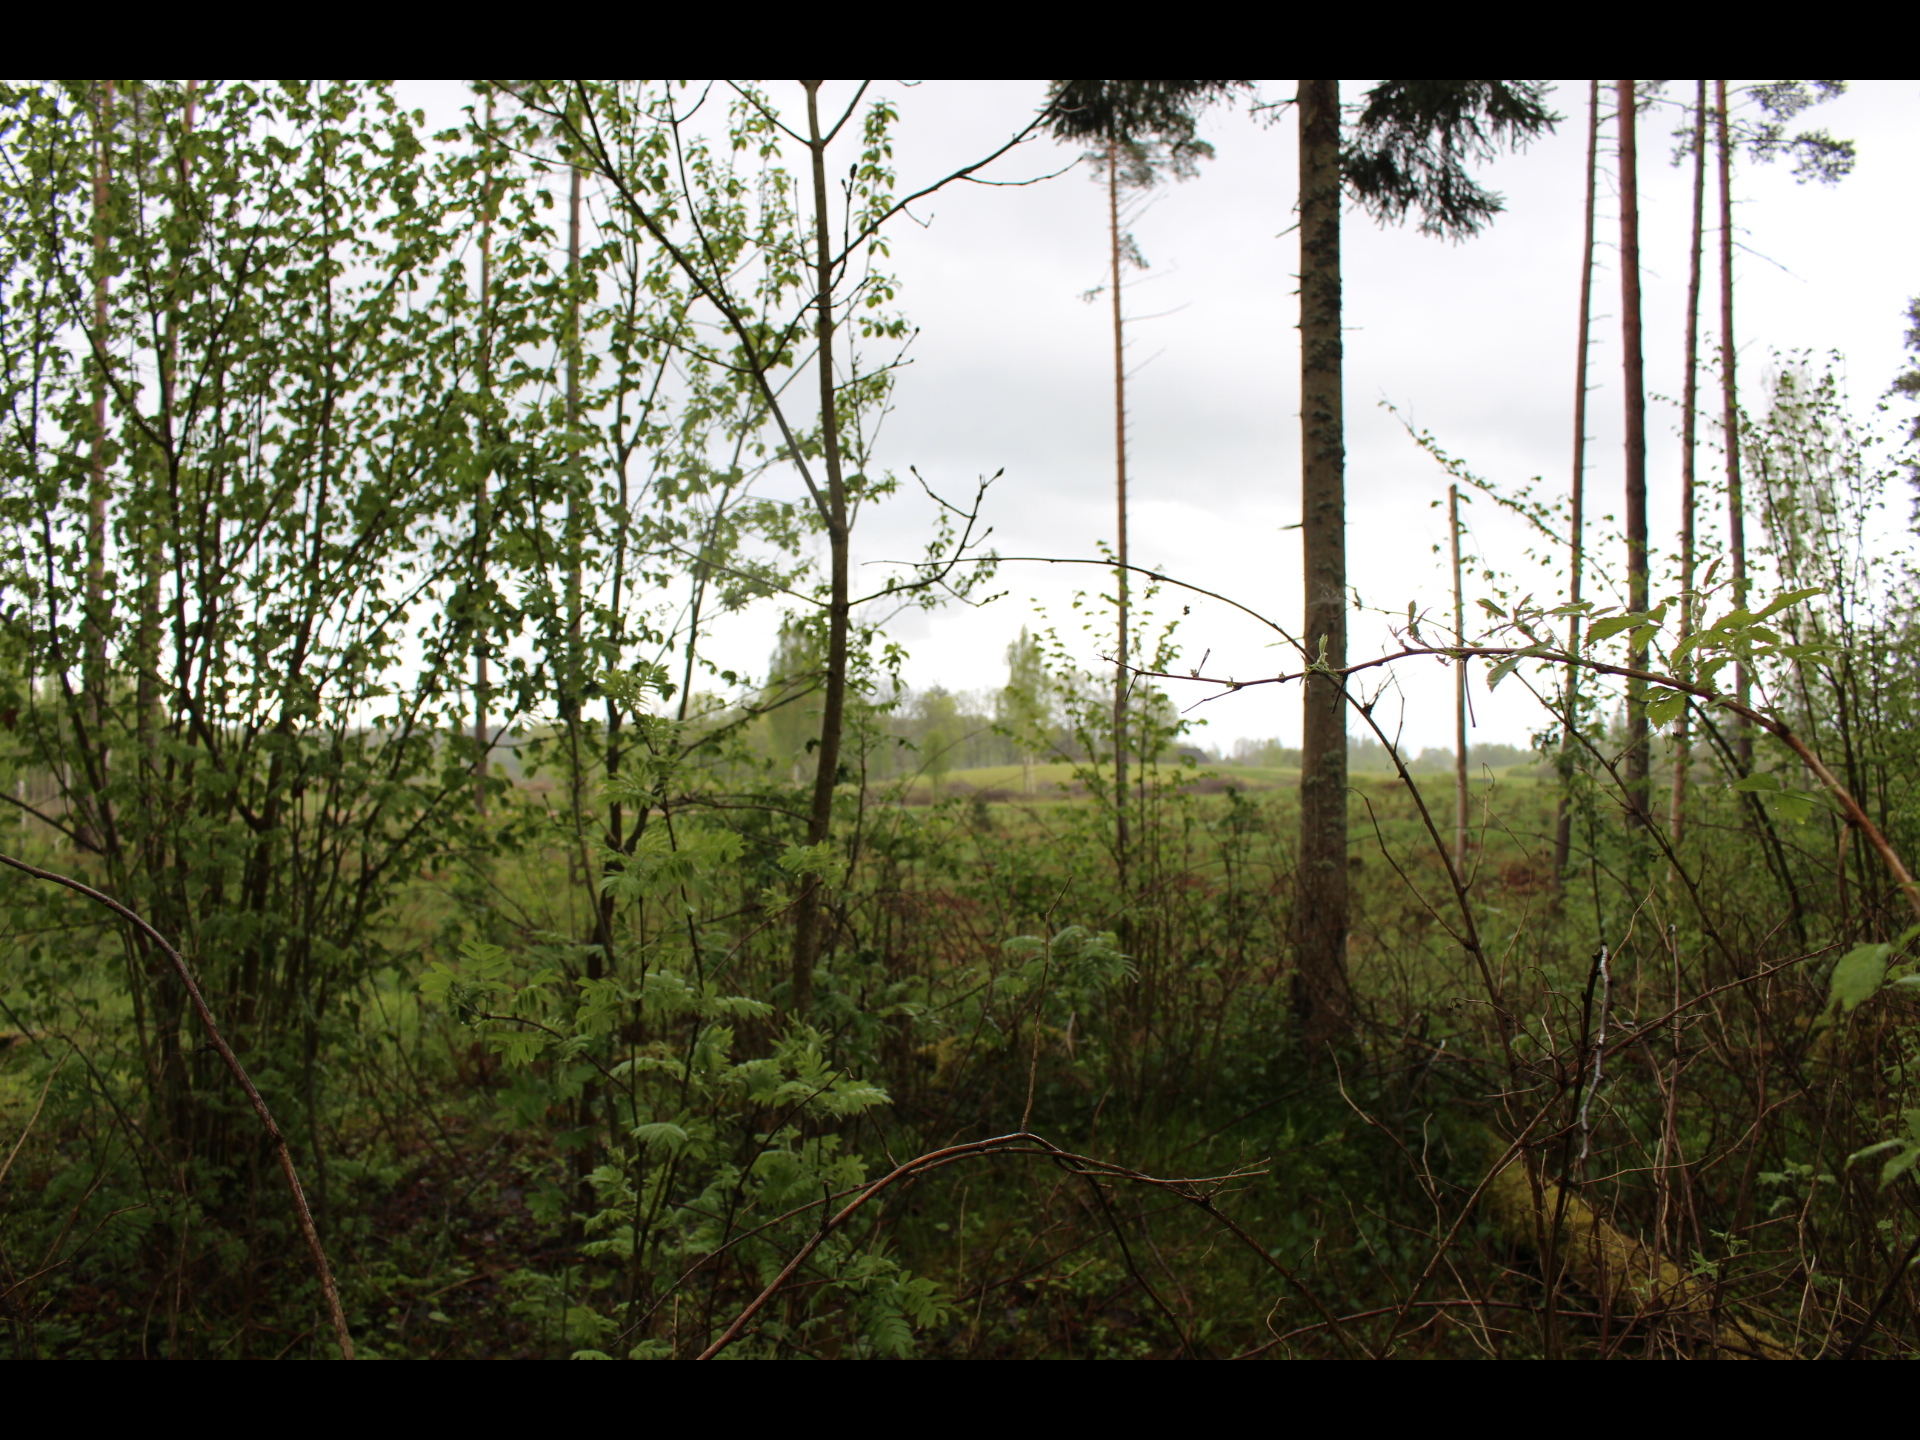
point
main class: Woodland
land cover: Pine dominated mixed woodland
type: hemiboreal forest and nemoral coniferous forest and mixed broadleaved-coniferous forest
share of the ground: > 75 %
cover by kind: broadleaved forest trees 60 %, coniferous forest trees 30 %, shrubs 10 %
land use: Forestry
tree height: > 5 m
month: May
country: LV
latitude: 56.7757
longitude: 22.8757
